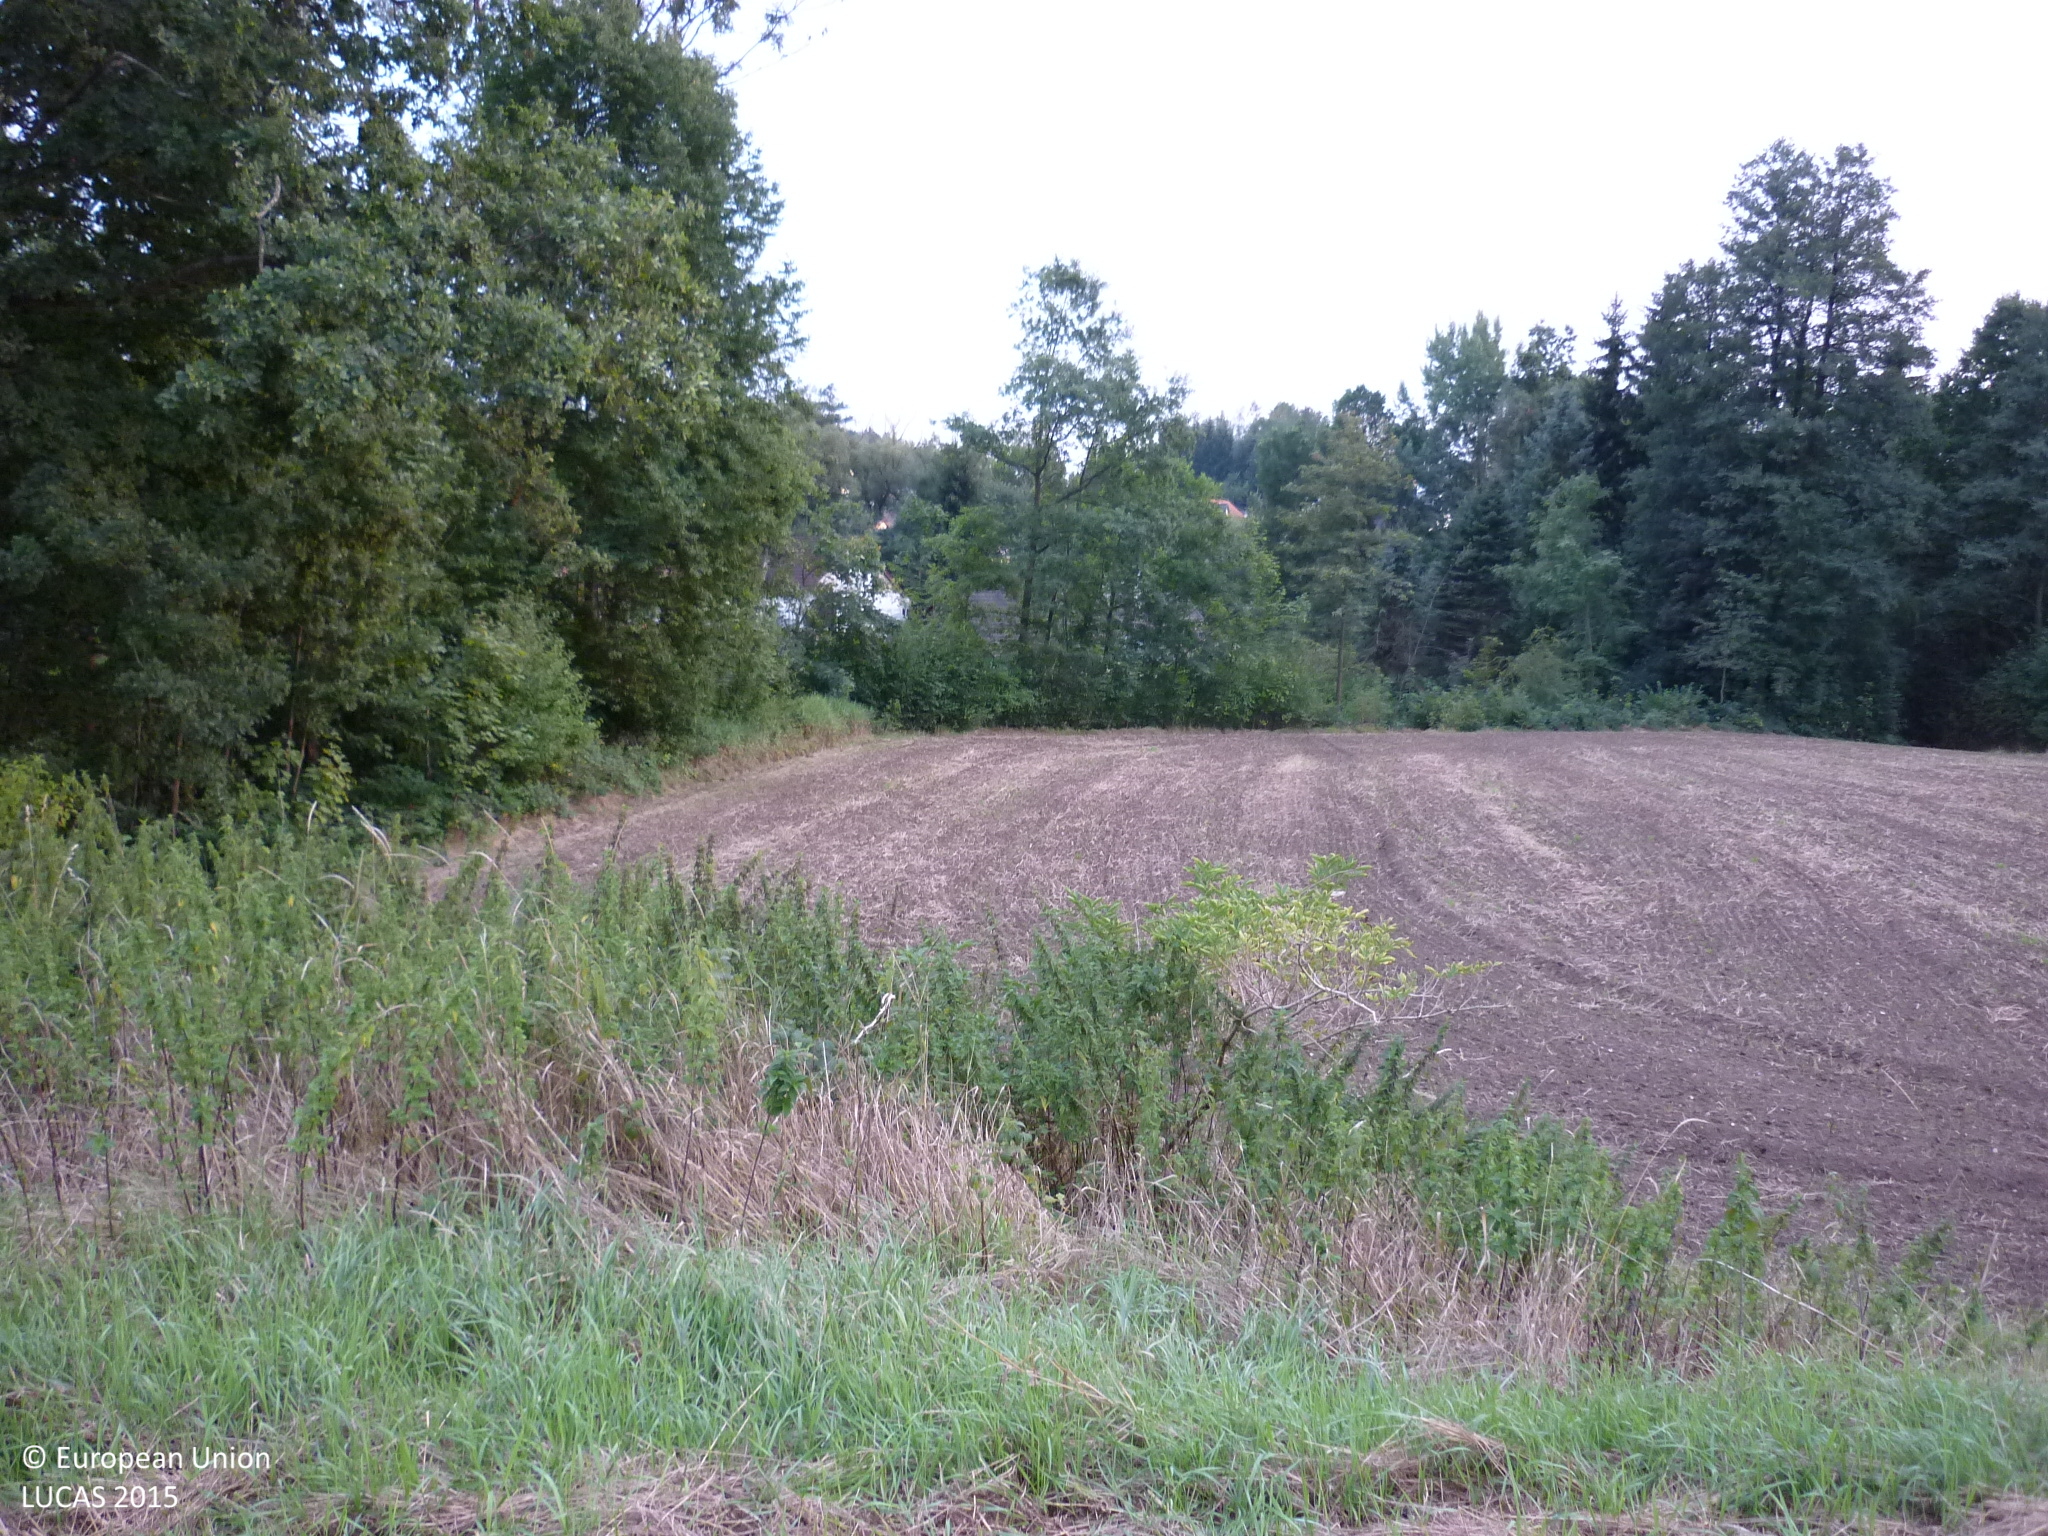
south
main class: Grassland
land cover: Spontaneously vegetated surfaces
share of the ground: 10 - 25 %
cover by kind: unconsolidated bare surface 85 %, herbaceous plants 15 %
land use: Agriculture (excluding fallow land and kitchen gardens)
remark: Harvested field
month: September
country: AT
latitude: 48.7761
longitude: 15.0233
